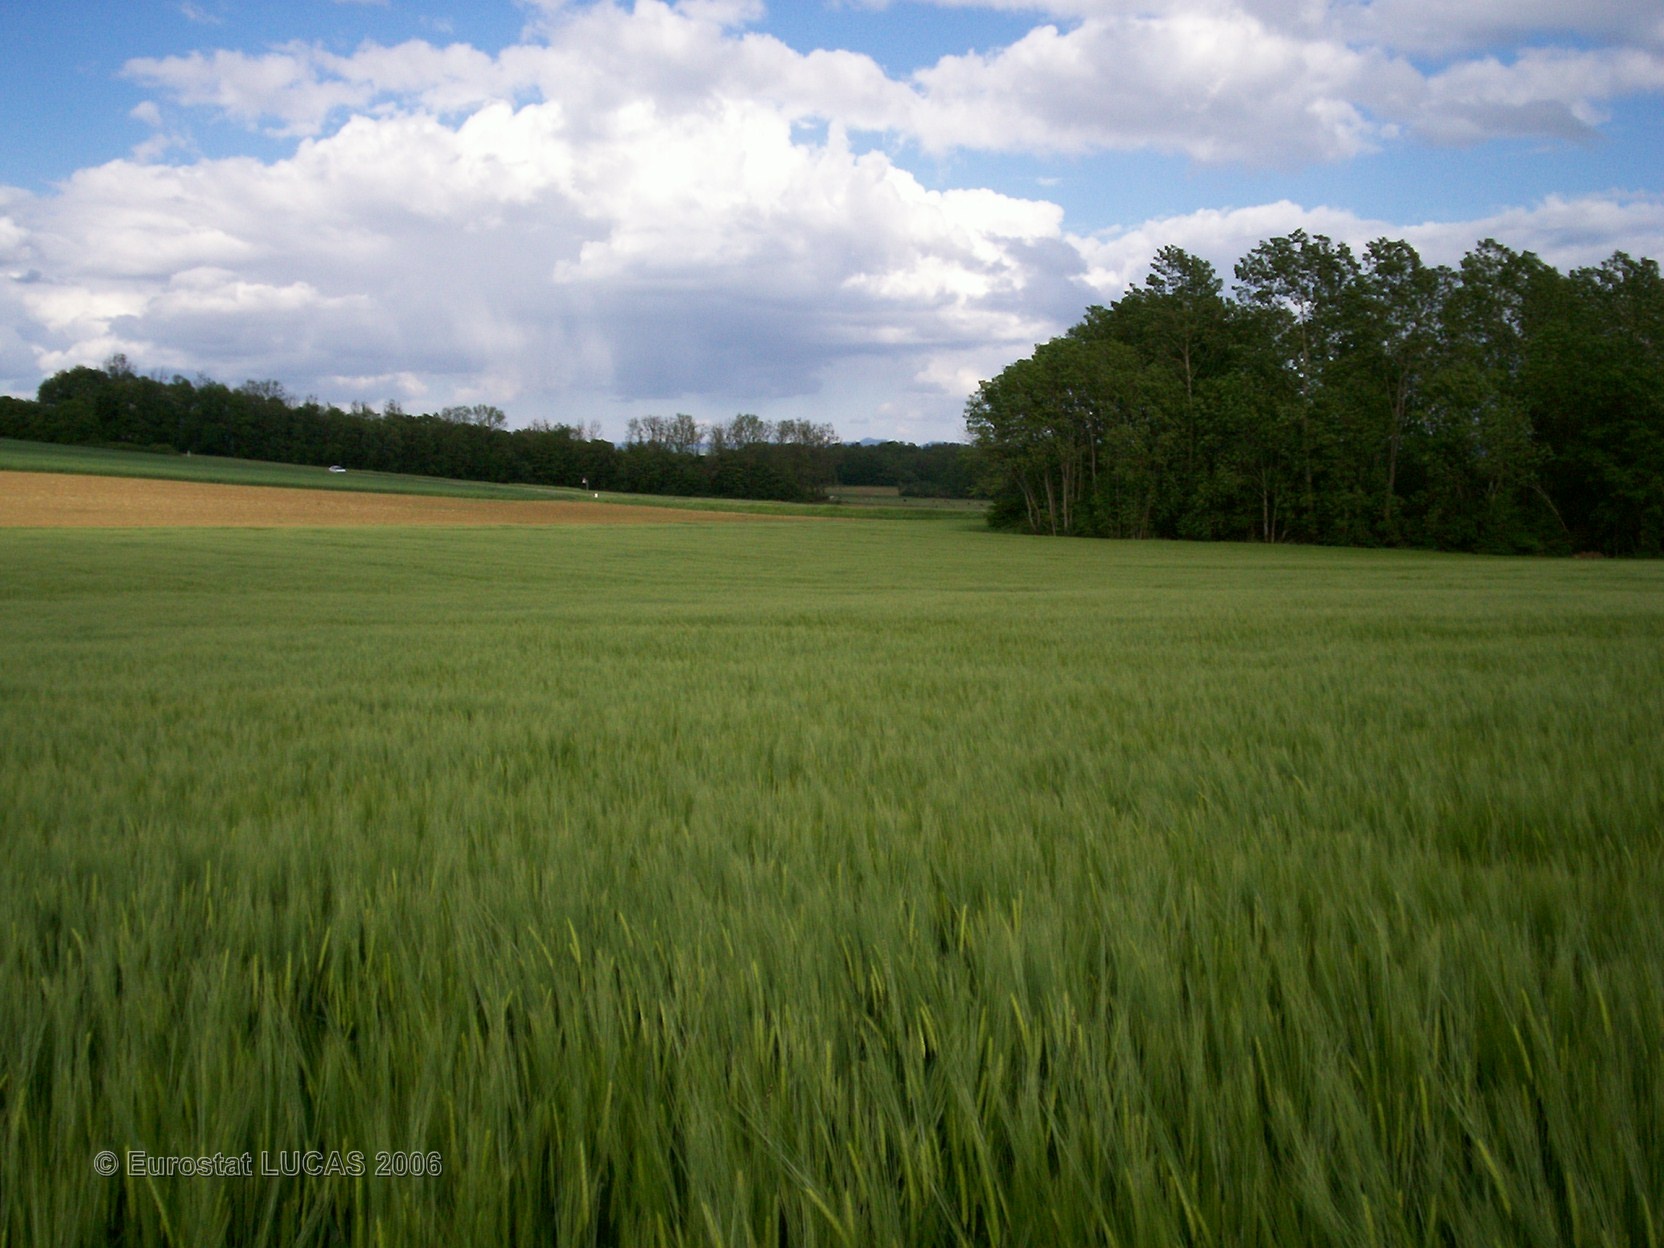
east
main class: Cropland
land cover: Barley
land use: Agriculture (excluding fallow land and kitchen gardens)
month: May
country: FR
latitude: 48.5011
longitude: 6.7931
